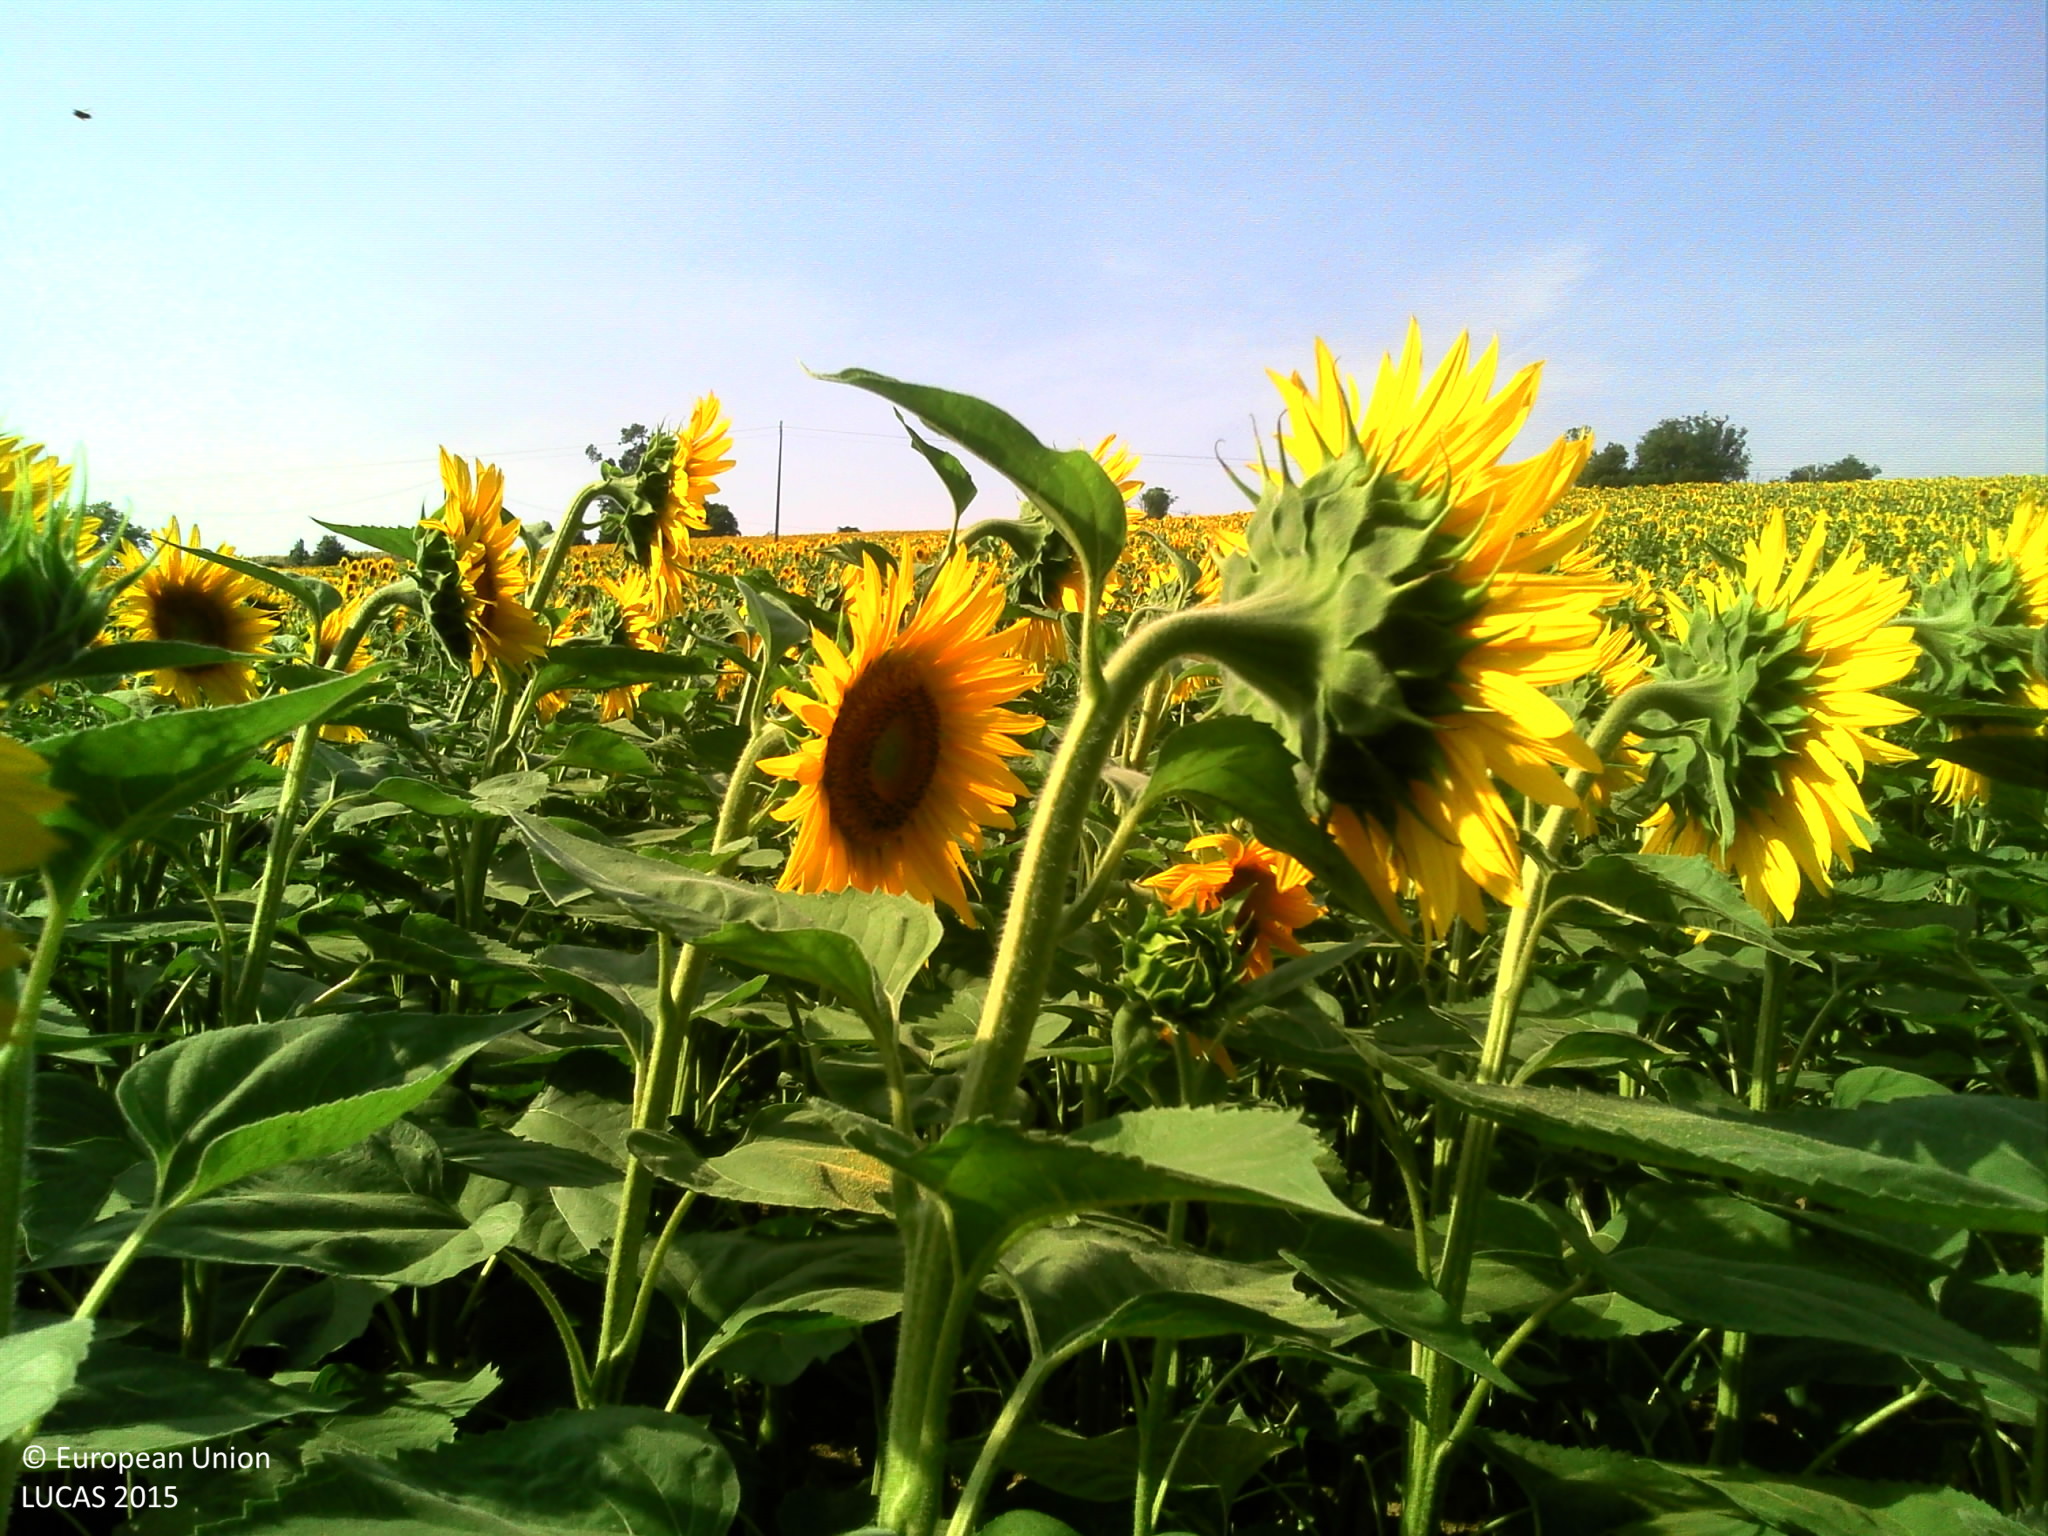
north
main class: Cropland
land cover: Sunflower
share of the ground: > 75 %
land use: Agriculture (excluding fallow land and kitchen gardens)
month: July
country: FR
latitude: 43.6457
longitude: 1.5852
